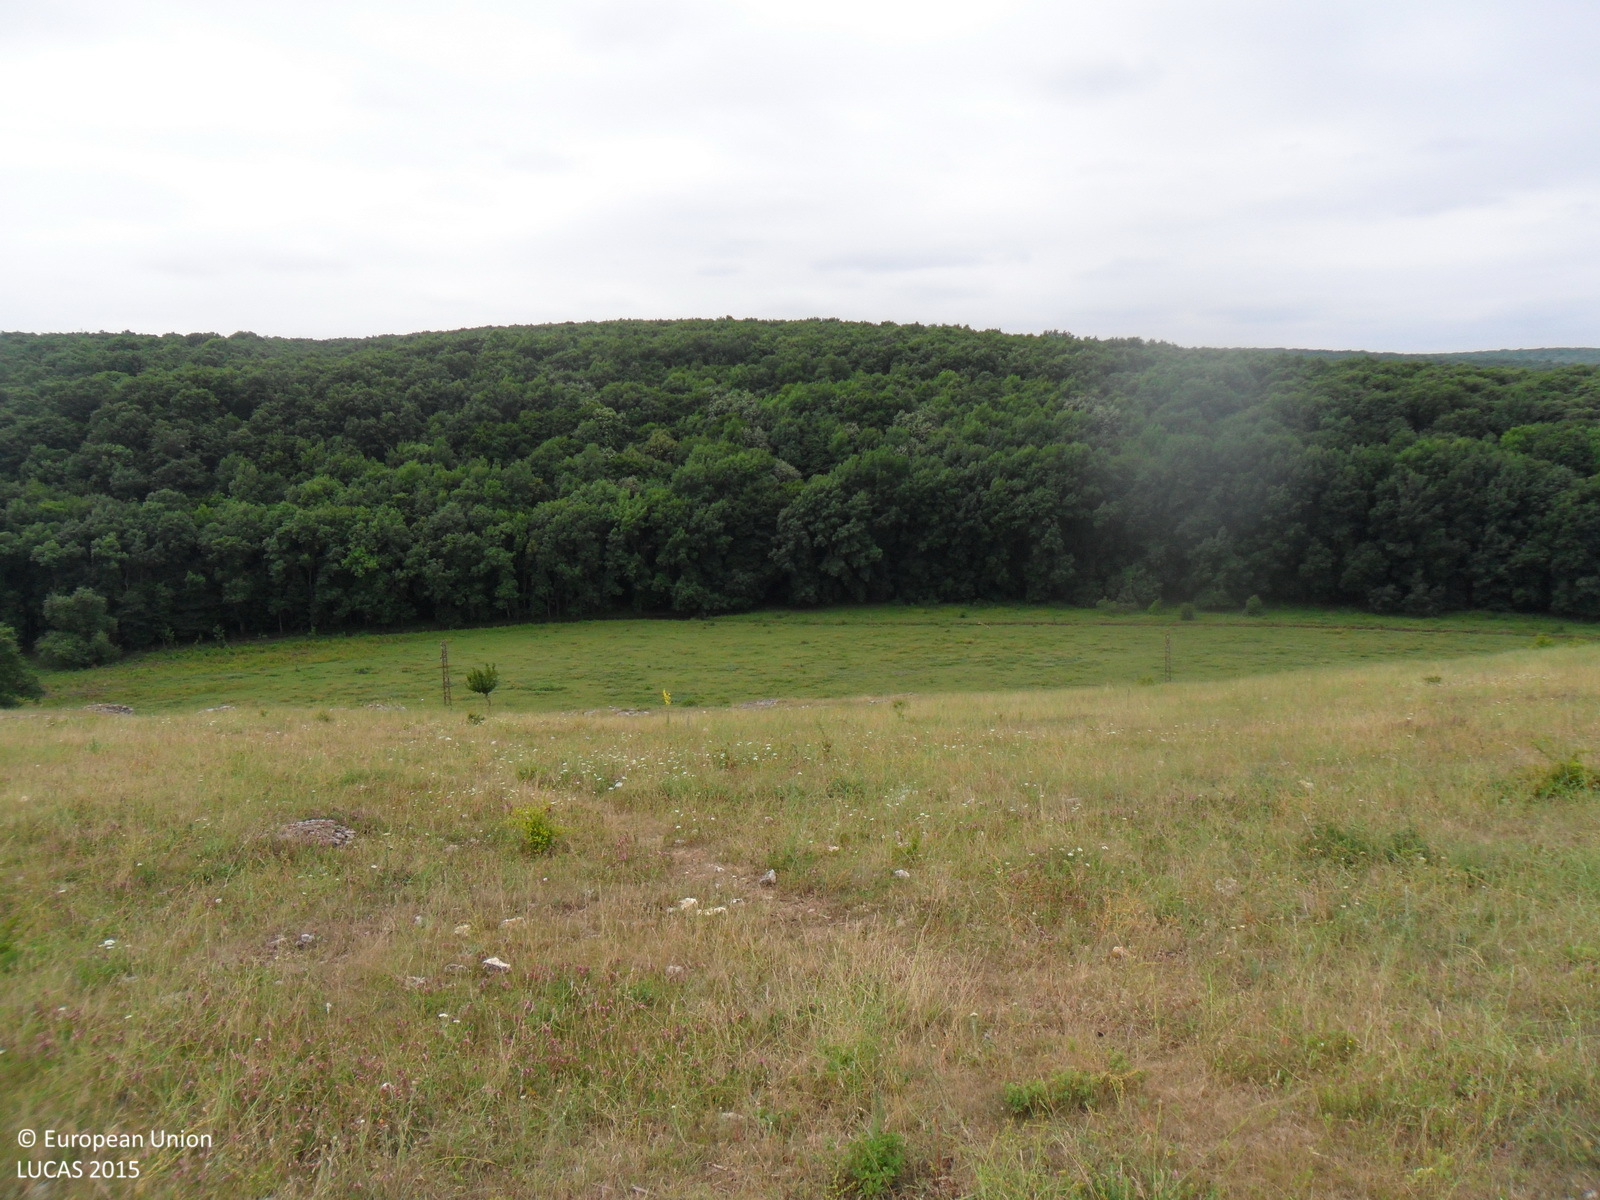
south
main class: Grassland
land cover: Grassland without tree/shrub cover
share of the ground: > 75 %
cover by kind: herbaceous plants 100 %
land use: Agriculture (excluding fallow land and kitchen gardens)
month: June
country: BG
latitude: 43.7373
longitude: 26.7132
